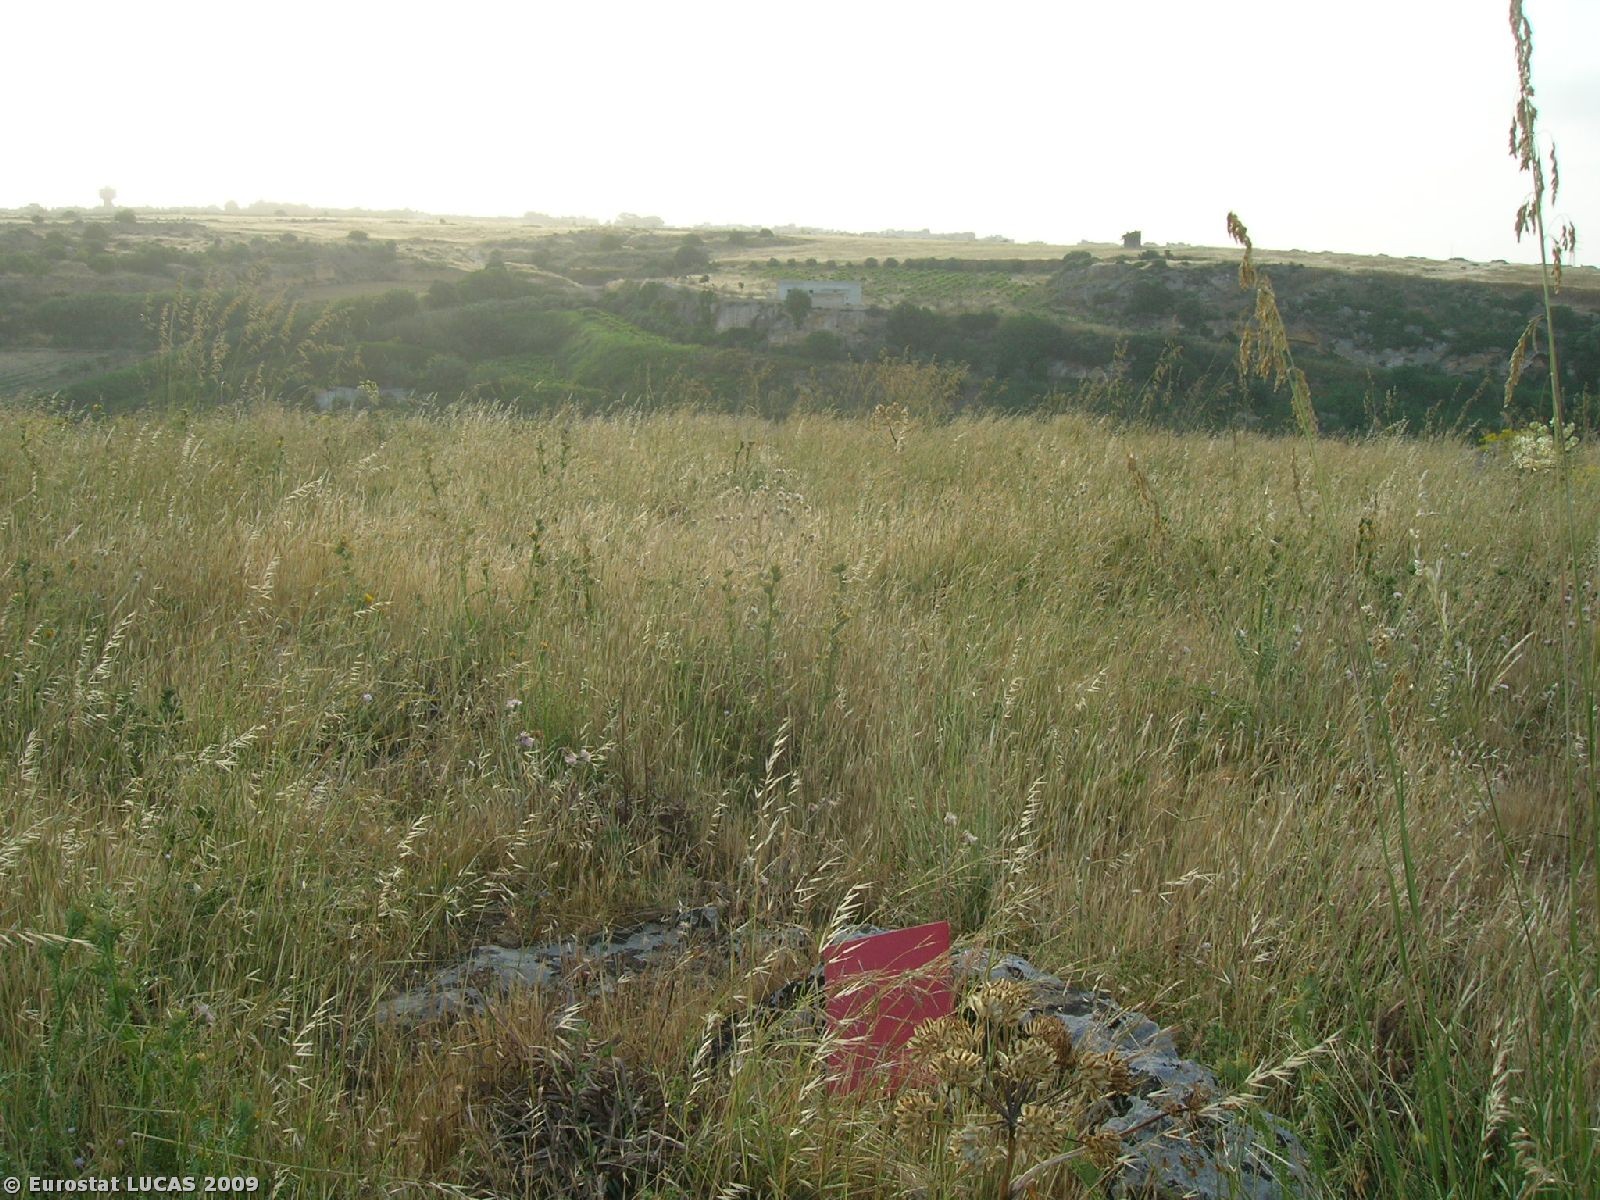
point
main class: Shrubland
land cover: Shrubland without tree cover
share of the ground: > 75 %
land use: Nature reserves
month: May
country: IT
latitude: 37.7114
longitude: 12.6232
